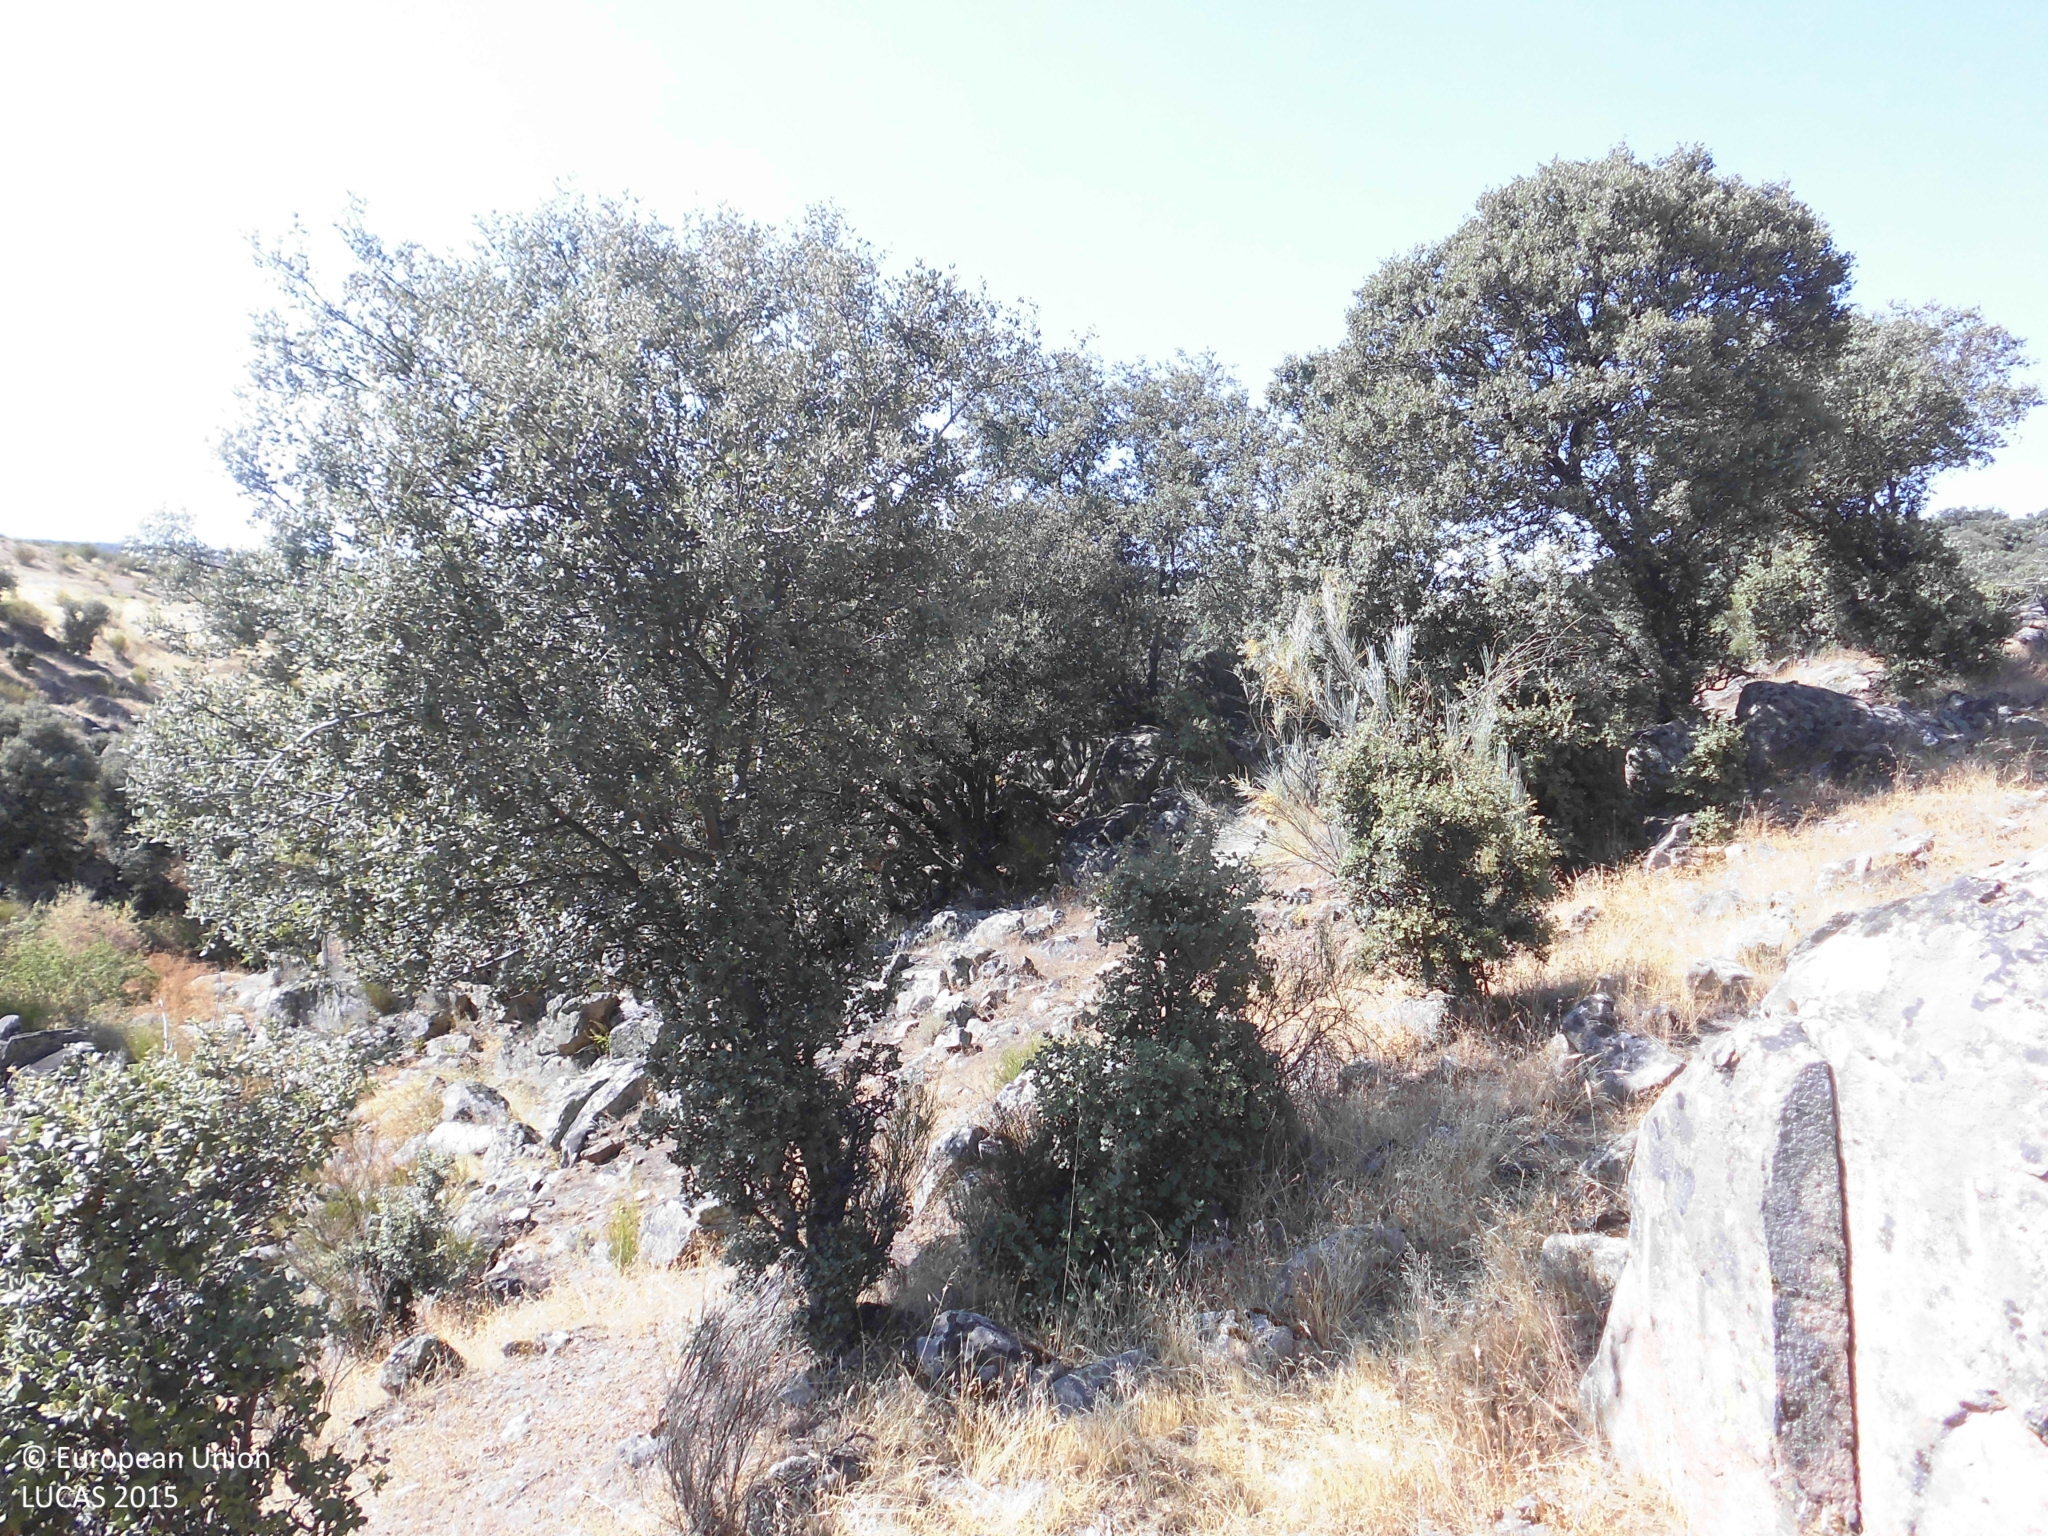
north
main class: Shrubland
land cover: Shrubland with sparse tree cover
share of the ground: 10 - 25 %
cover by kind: herbaceous plants 70 %, shrubs 25 %, broadleaved forest trees 5 %
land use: Agriculture (excluding fallow land and kitchen gardens)
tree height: > 5 m
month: July
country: ES
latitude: 40.1155
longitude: -6.0406
